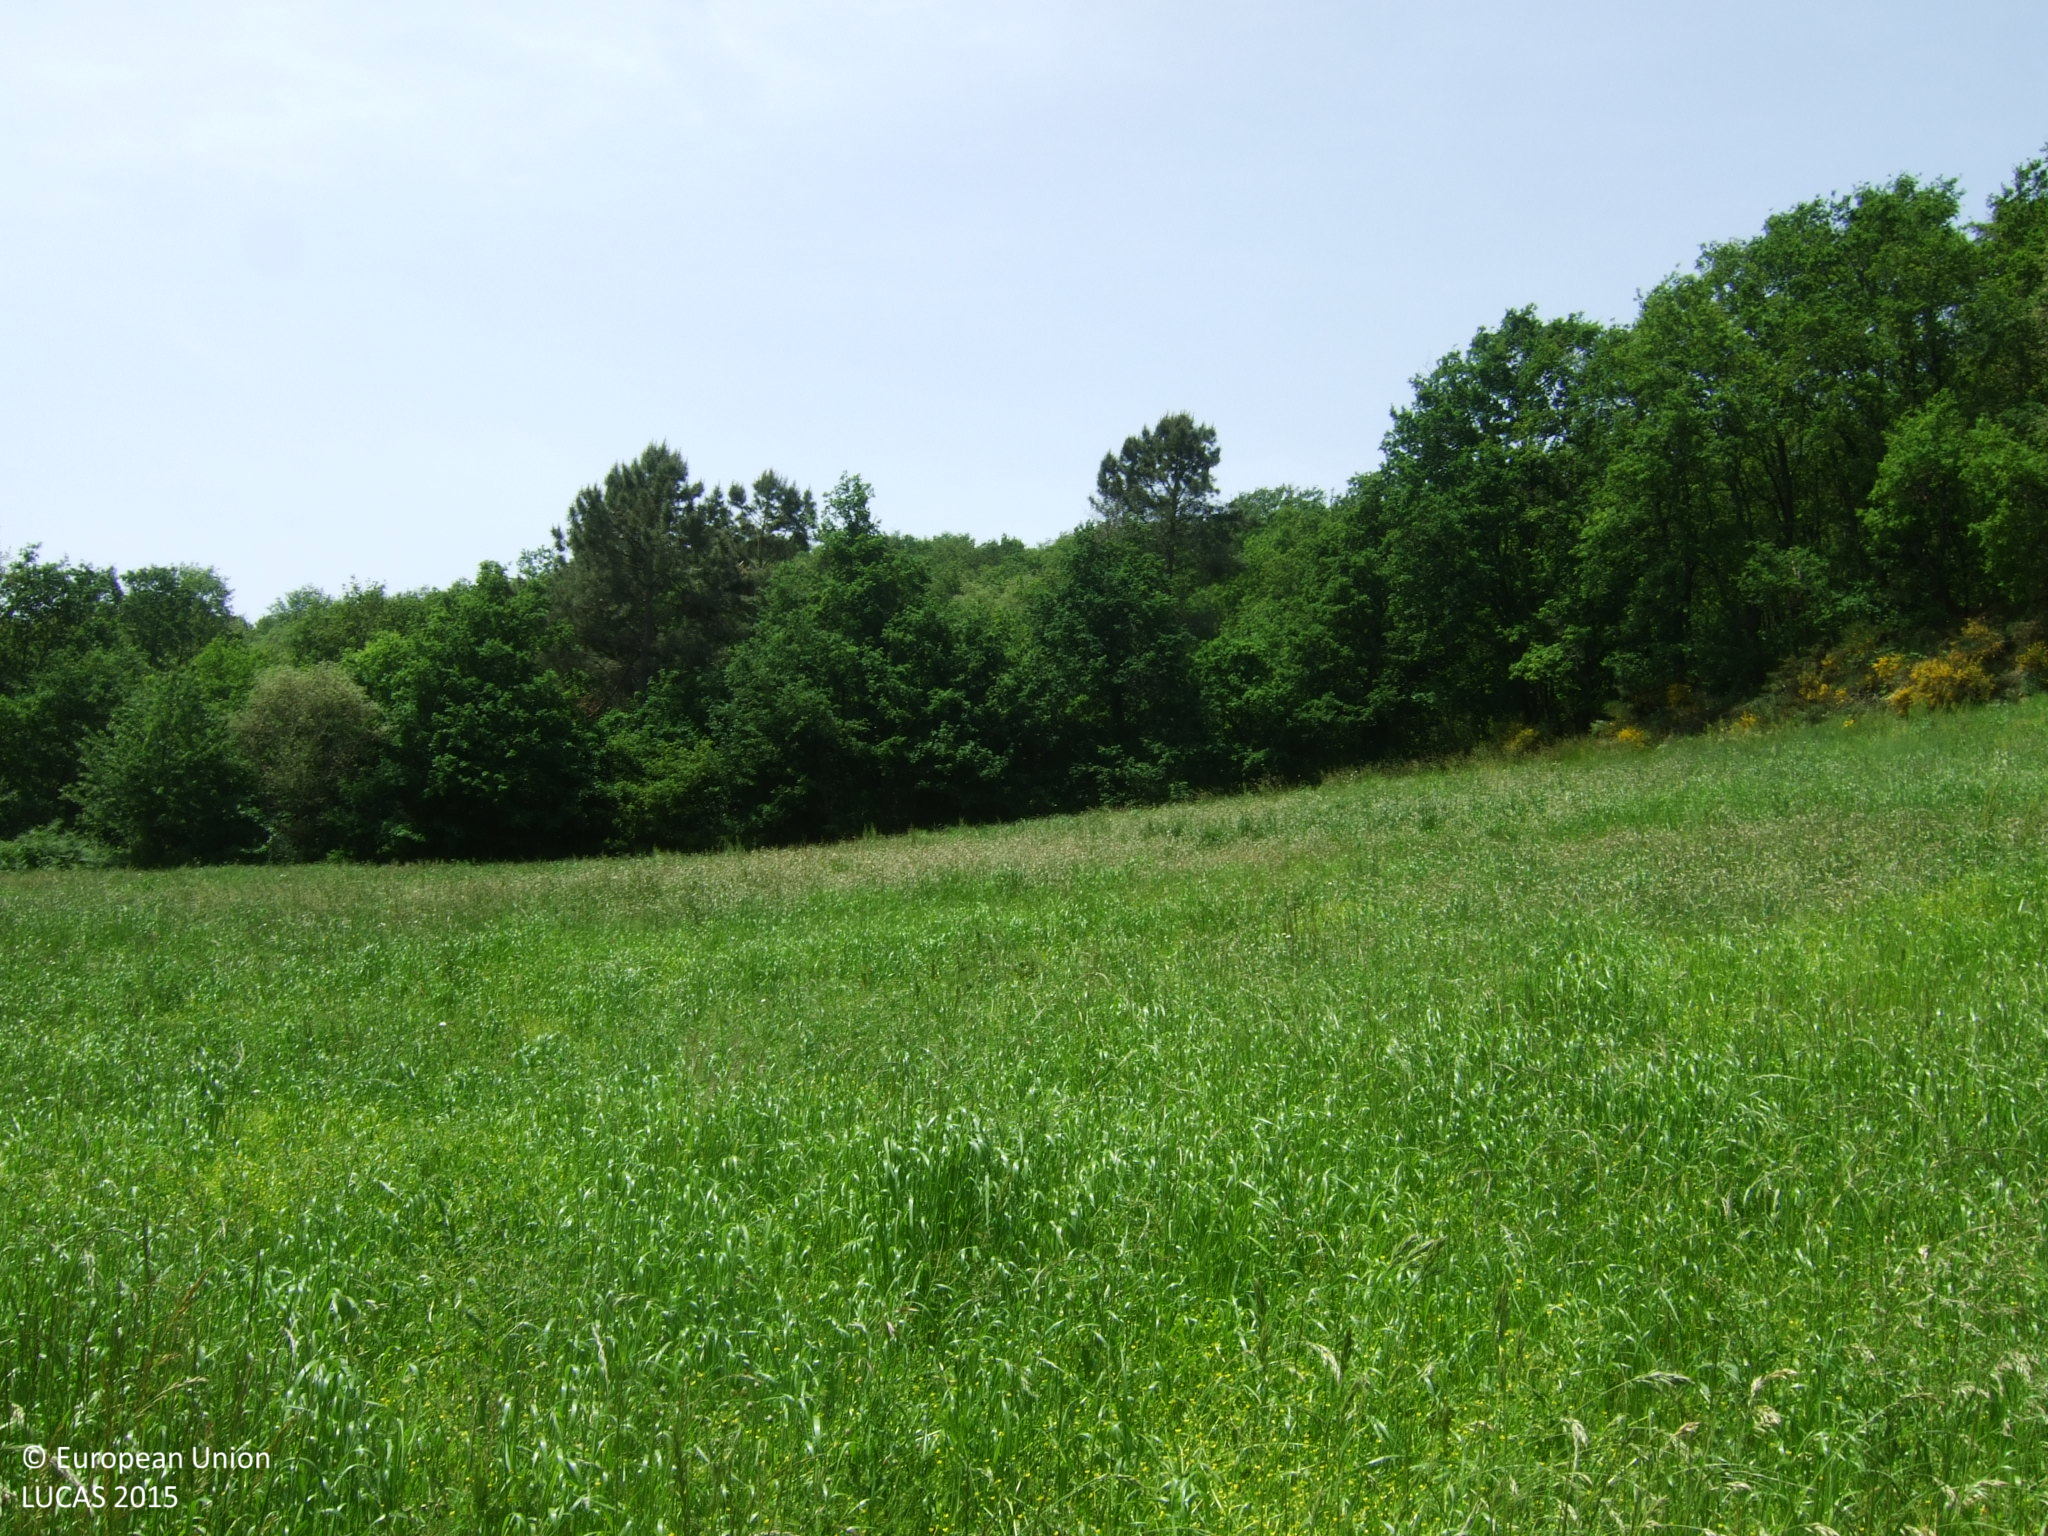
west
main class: Grassland
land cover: Grassland without tree/shrub cover
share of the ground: > 75 %
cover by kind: herbaceous plants 100 %
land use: Agriculture (excluding fallow land and kitchen gardens)
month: May
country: ES
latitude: 42.8506
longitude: -7.3861
